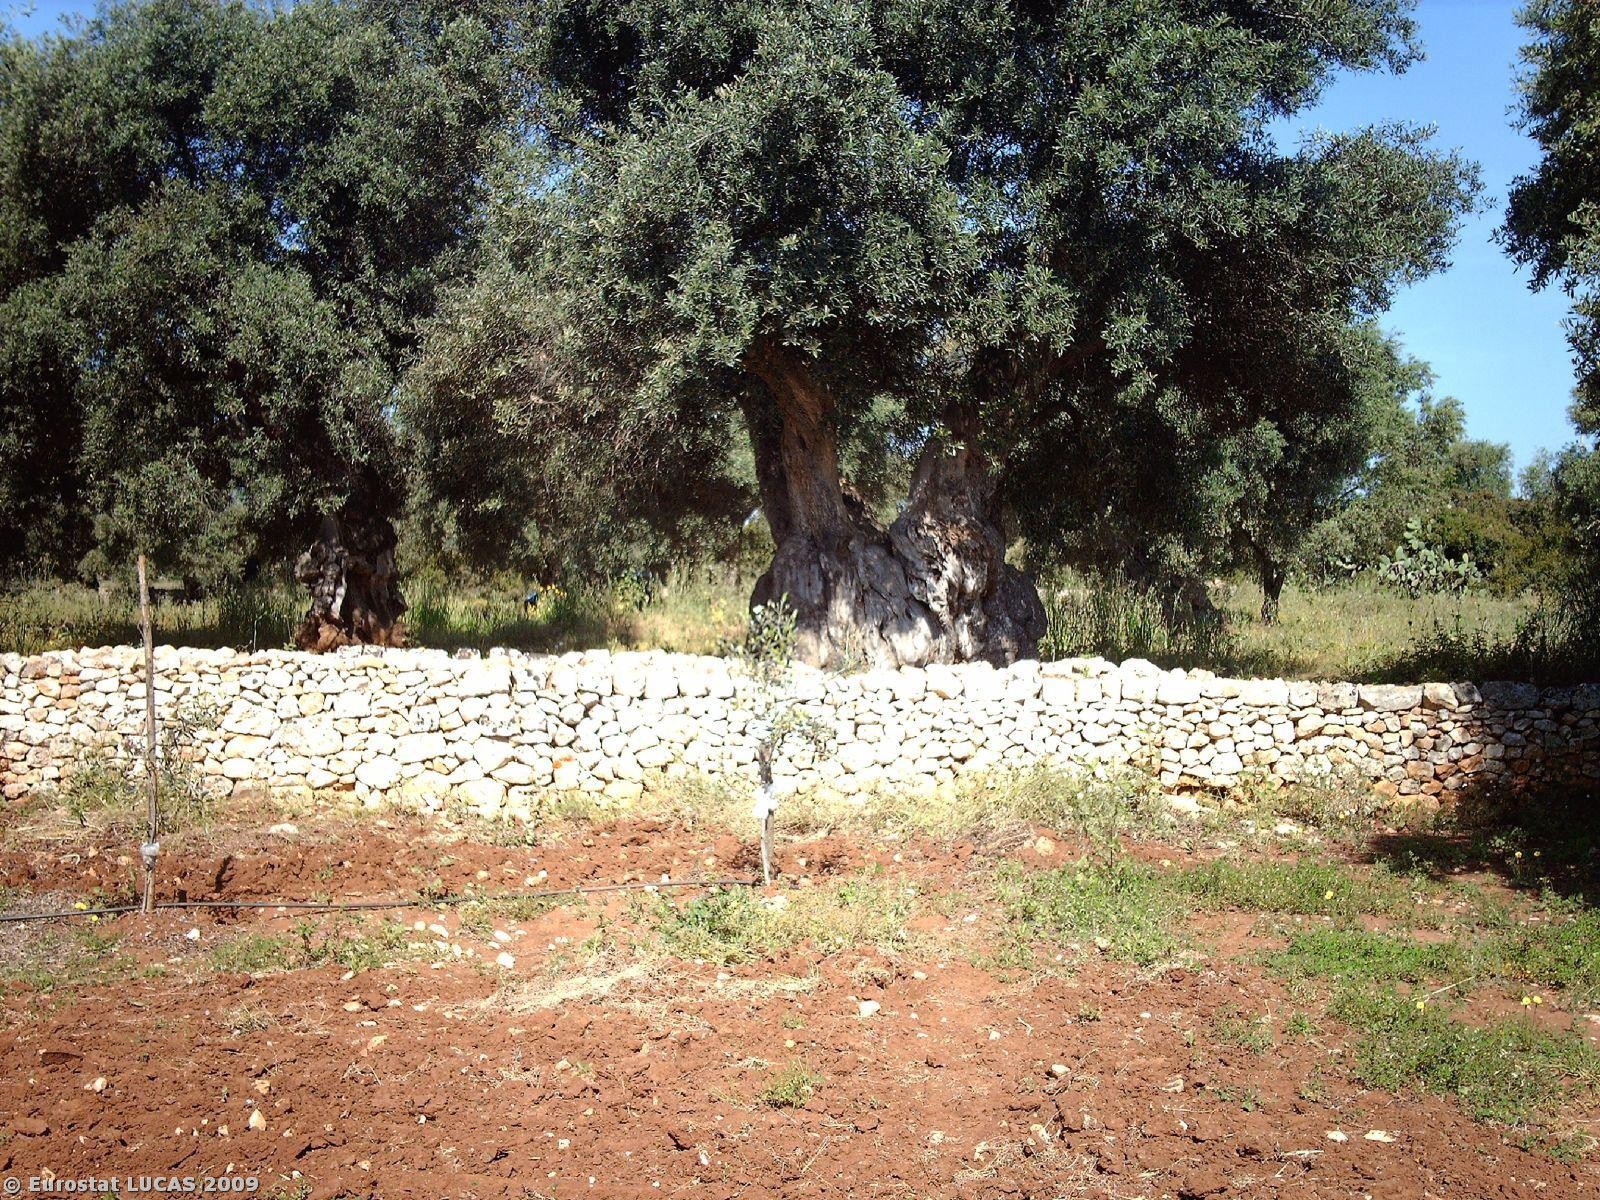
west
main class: Cropland
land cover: Olive groves
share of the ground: 10 - 25 %
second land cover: Bare land
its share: > 75 %
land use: Agriculture (excluding fallow land and kitchen gardens)
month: May
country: IT
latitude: 40.7574
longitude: 17.5466
